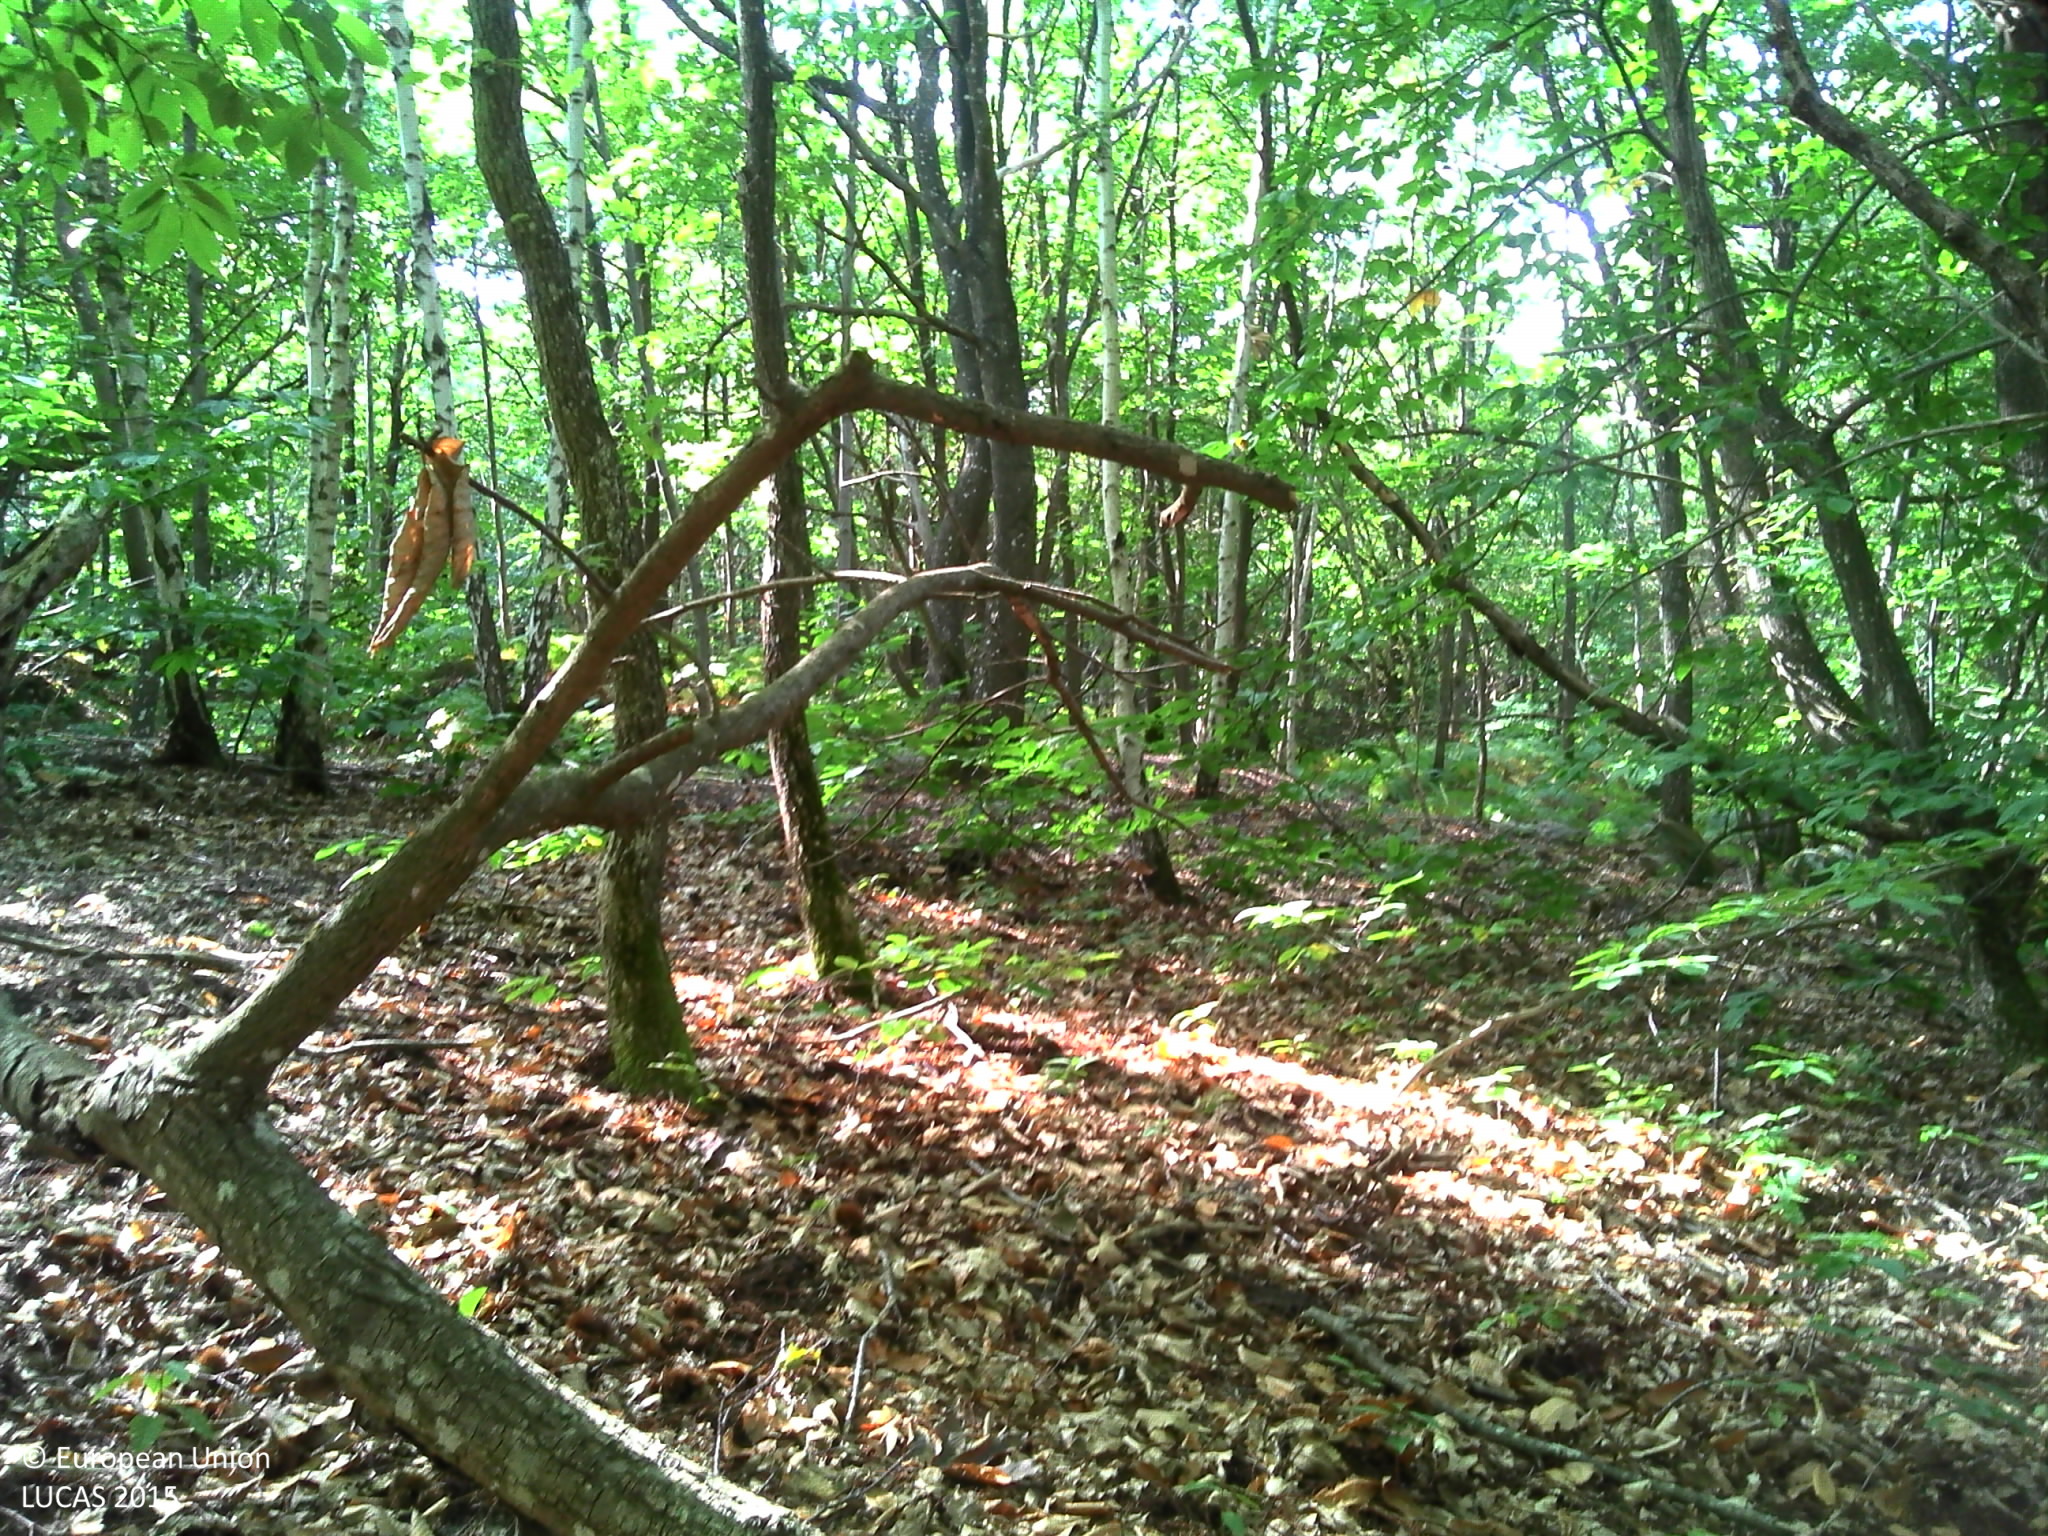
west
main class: Woodland
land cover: Broadleaved woodland
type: acidophilous oak and oak-birch forest
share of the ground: > 75 %
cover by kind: broadleaved forest trees 80 %, shrubs 10 %, herbaceous plants 5 %, lichens and mosses 5 %
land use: Forestry
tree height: > 5 m
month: September
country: FR
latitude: 48.2741
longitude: 2.7556
